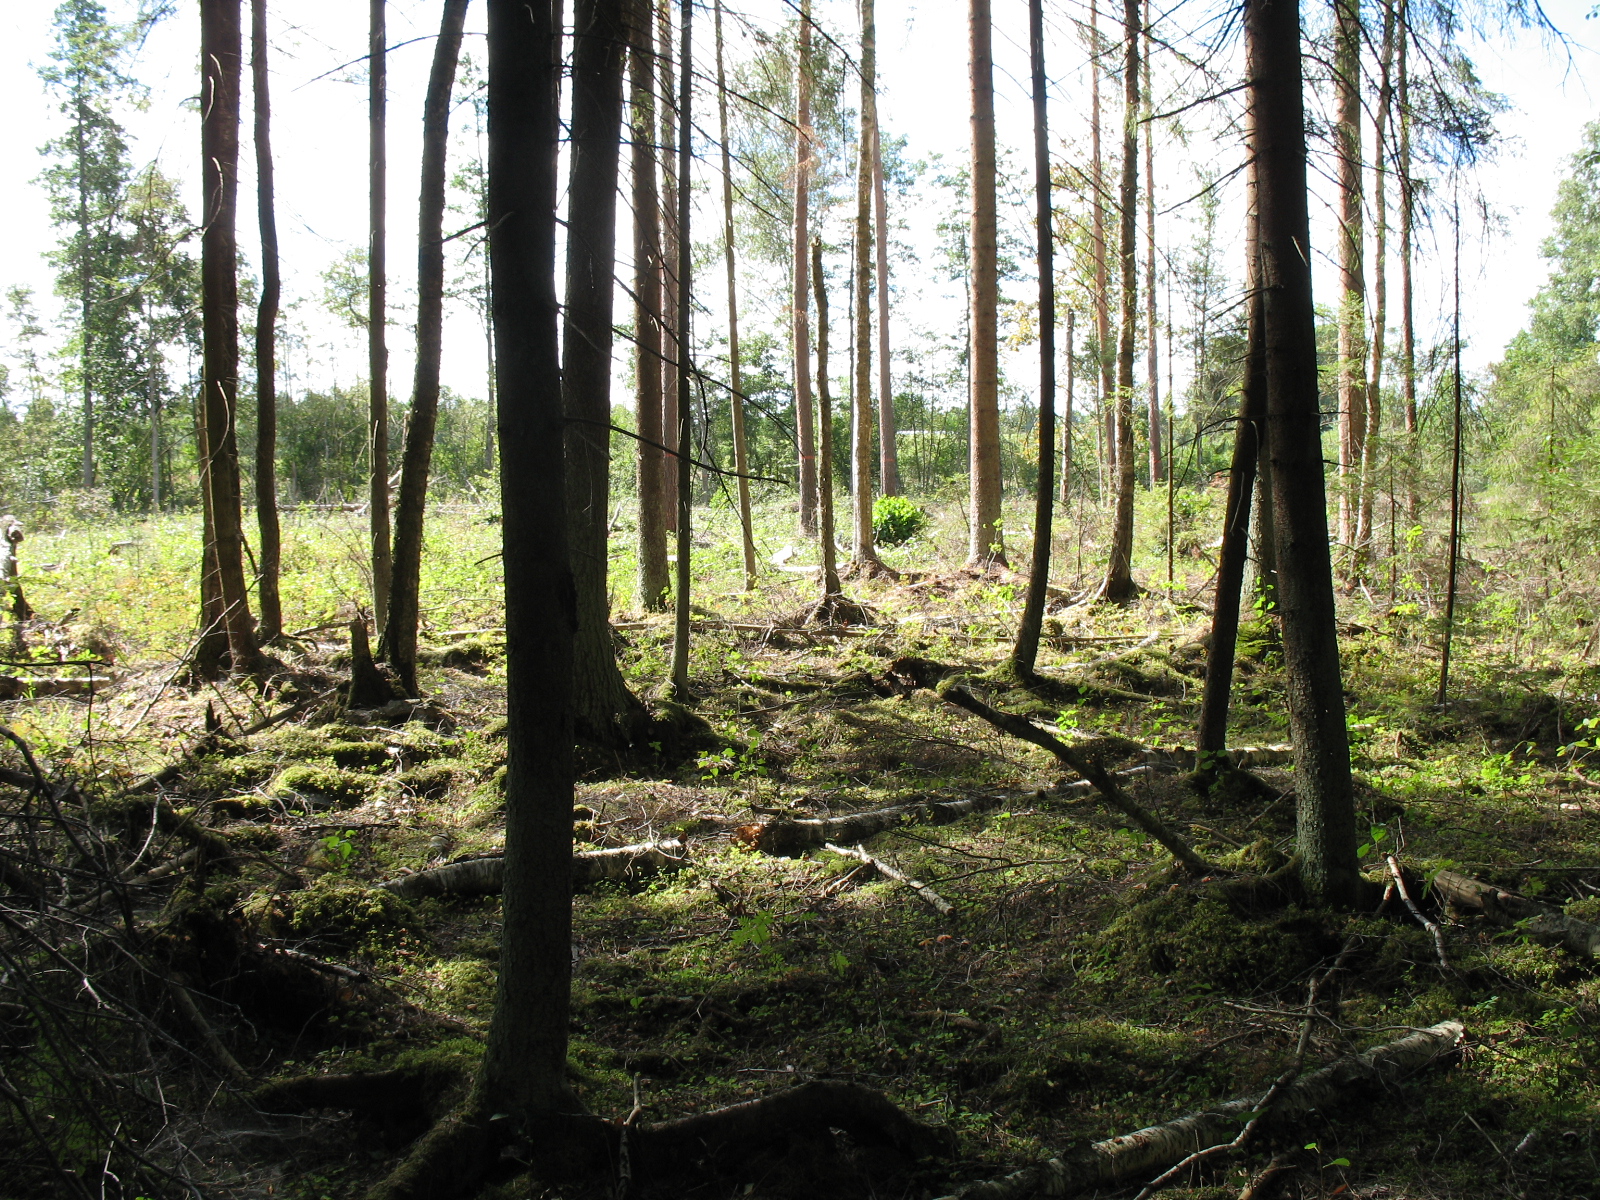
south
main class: Woodland
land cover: Other mixed woodland
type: hemiboreal forest and nemoral coniferous forest and mixed broadleaved-coniferous forest
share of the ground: > 75 %
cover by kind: coniferous forest trees 50 %, broadleaved forest trees 30 %, lichens and mosses 15 %, shrubs 5 %
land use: Forestry
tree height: > 5 m
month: August
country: LV
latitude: 56.4488
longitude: 25.6502
